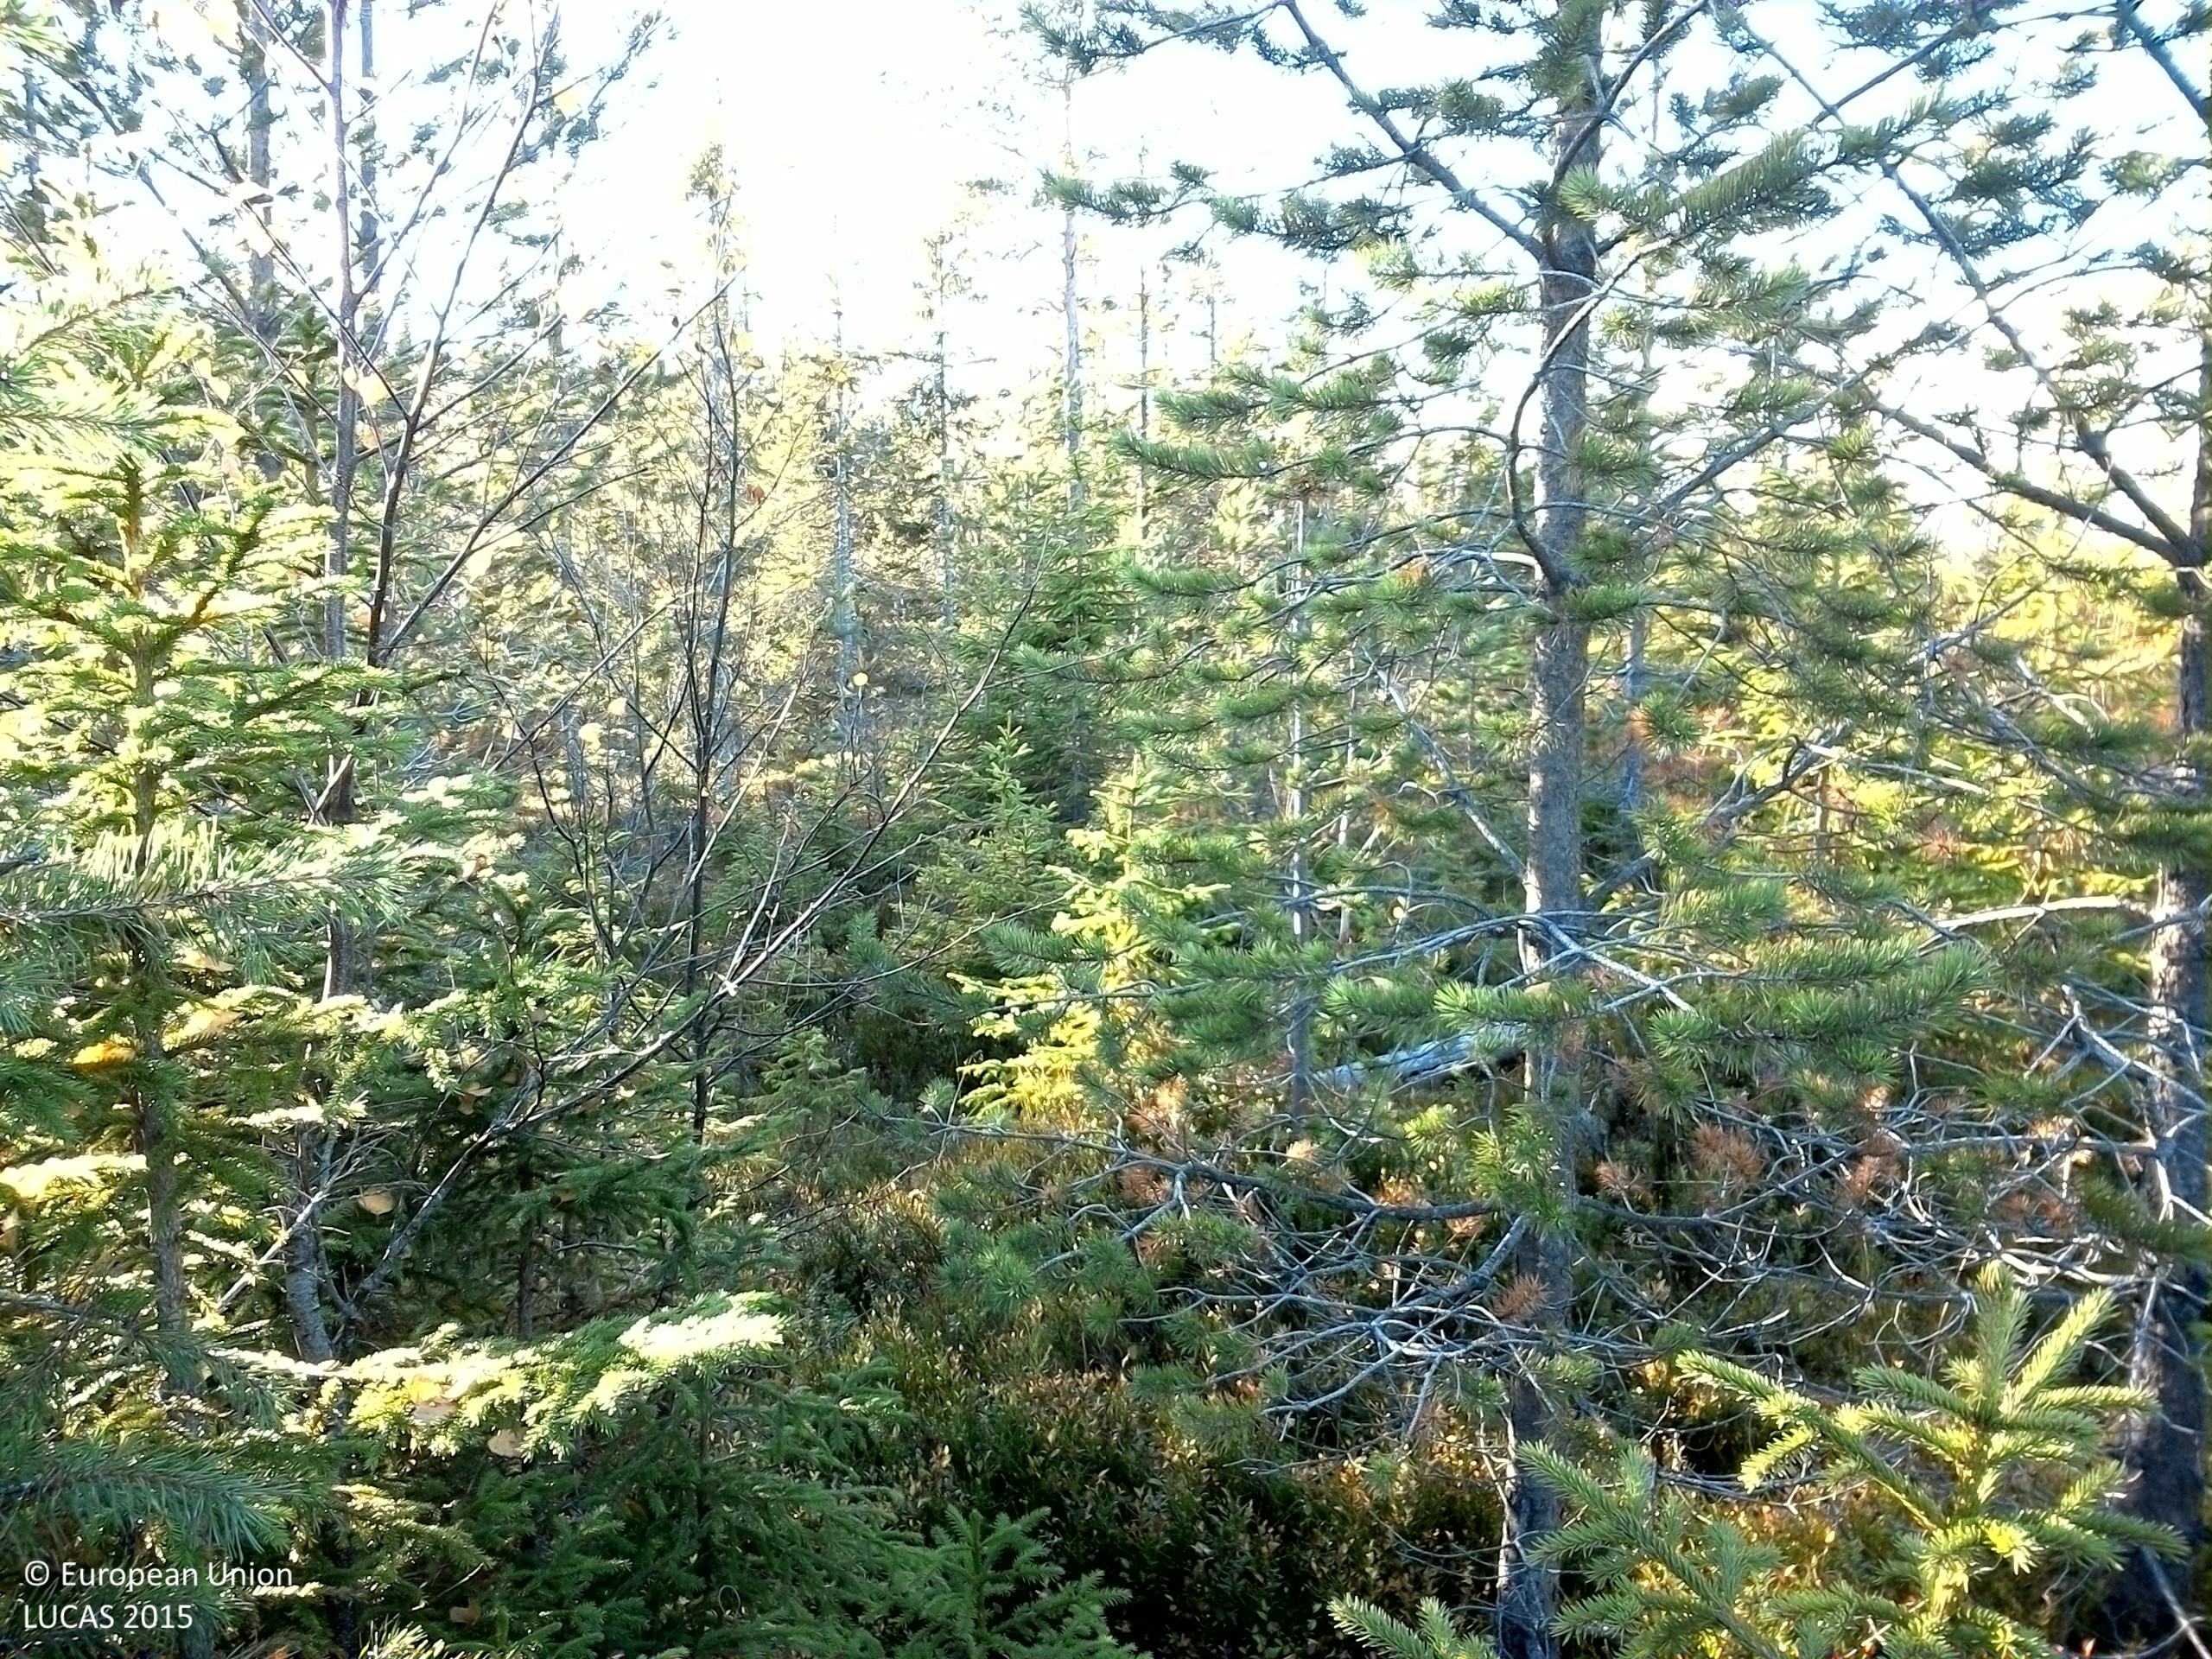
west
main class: Woodland
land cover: Other coniferous woodland
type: boreal forest
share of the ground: 50 - 75 %
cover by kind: coniferous forest trees 60 %, shrubs 25 %, lichens and mosses 10 %, broadleaved forest trees 5 %
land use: Forestry
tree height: < 5 m
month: October
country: SE
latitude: 61.3060
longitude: 14.8583
